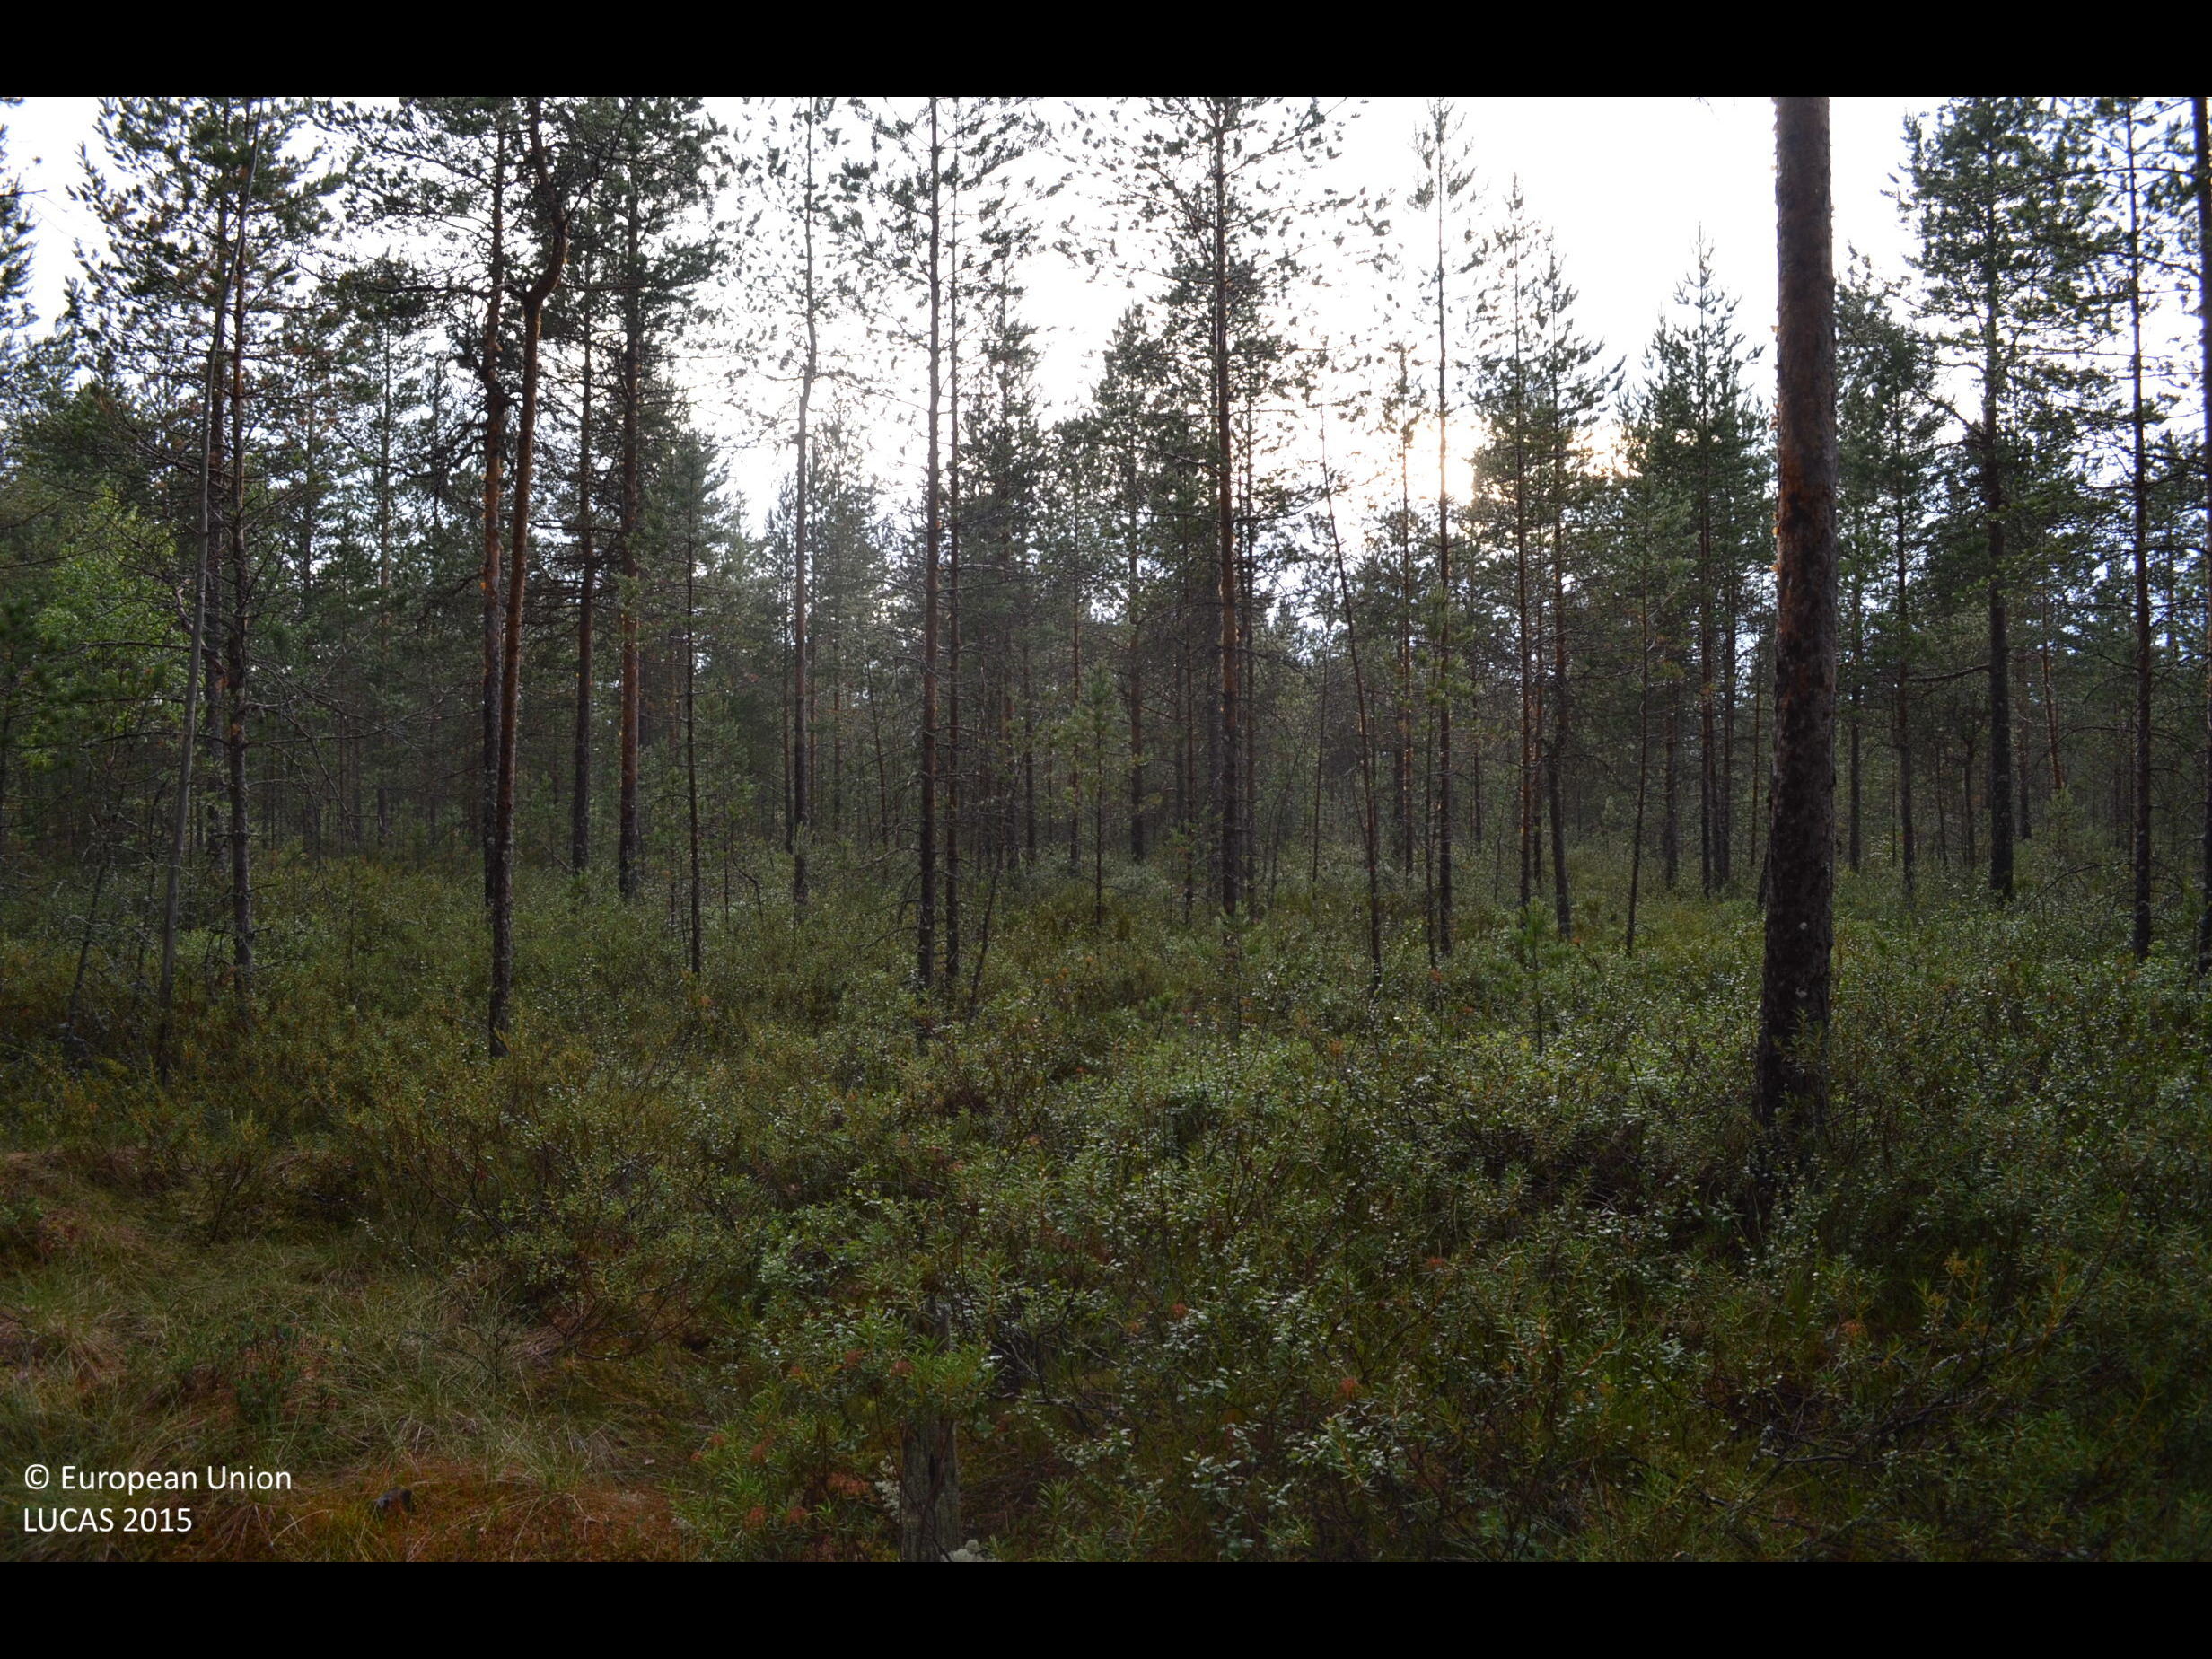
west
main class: Woodland
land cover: Pine dominated coniferous woodland
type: boreal forest
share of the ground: 50 - 75 %
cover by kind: coniferous forest trees 55 %, shrubs 35 %, broadleaved forest trees 5 %, unconsolidated bare surface 5 %
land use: Forestry
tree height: > 5 m
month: July
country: FI
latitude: 62.2296
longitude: 23.4042
